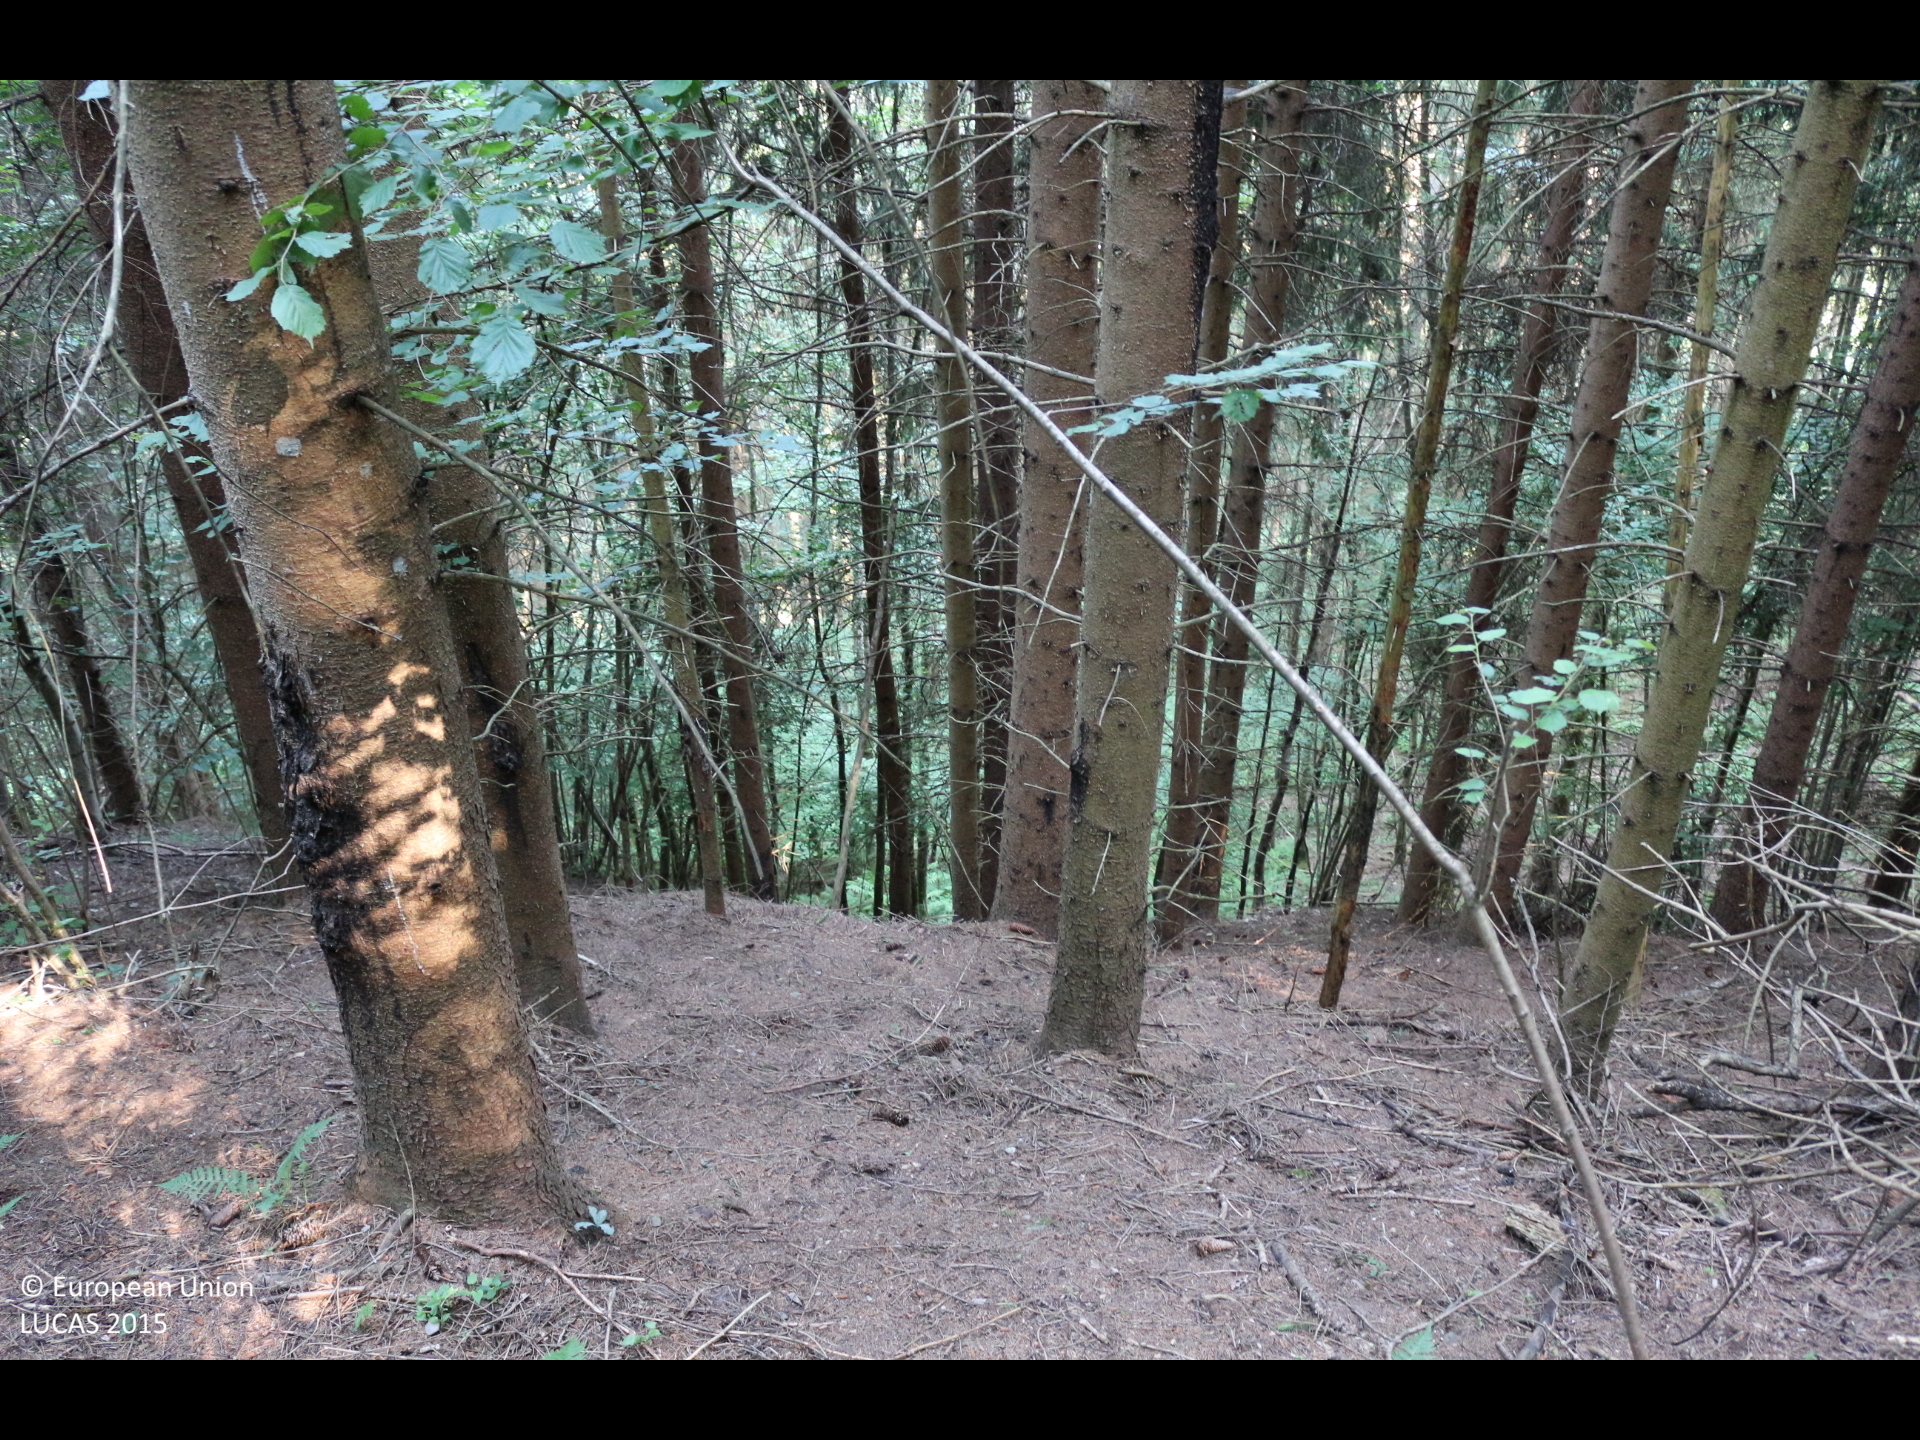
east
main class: Woodland
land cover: Spruce dominated mixed woodland
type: alpine coniferous forest
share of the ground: > 75 %
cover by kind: coniferous forest trees 60 %, broadleaved forest trees 40 %
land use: Forestry
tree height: > 5 m
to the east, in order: Spruce dominated mixed woodland; Shrubland with sparse tree cover; Spruce dominated mixed woodland; Grass margins; Paved roads, cycling and walking lanes; Grass margins; Artificial constructions; Spruce dominated mixed woodland; Tracks; Spruce dominated mixed woodland; Inland fresh running water; Spontaneously vegetated surfaces; Broadleaved woodland
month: July
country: AT
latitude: 46.7767
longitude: 14.1231
